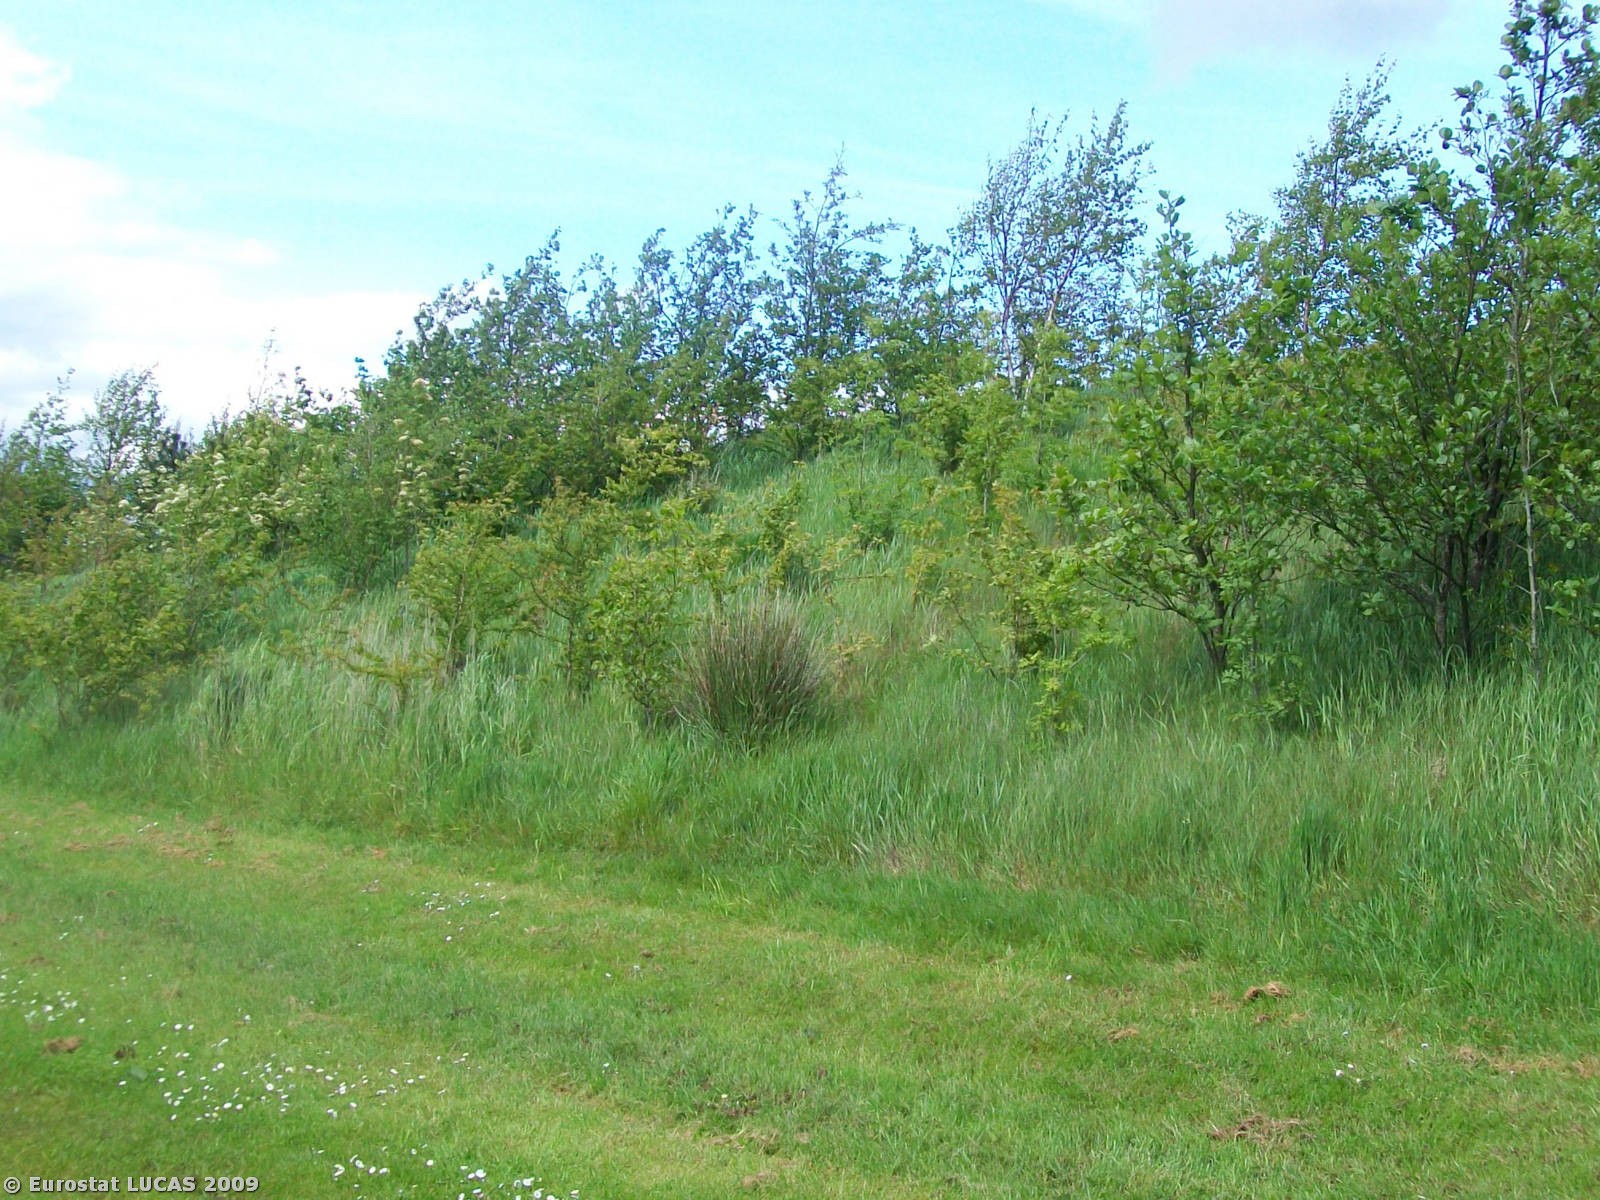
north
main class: Grassland
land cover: Grassland without tree/shrub cover
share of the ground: > 75 %
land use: Sport
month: May
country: GB
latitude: 54.5785
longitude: -5.7758
